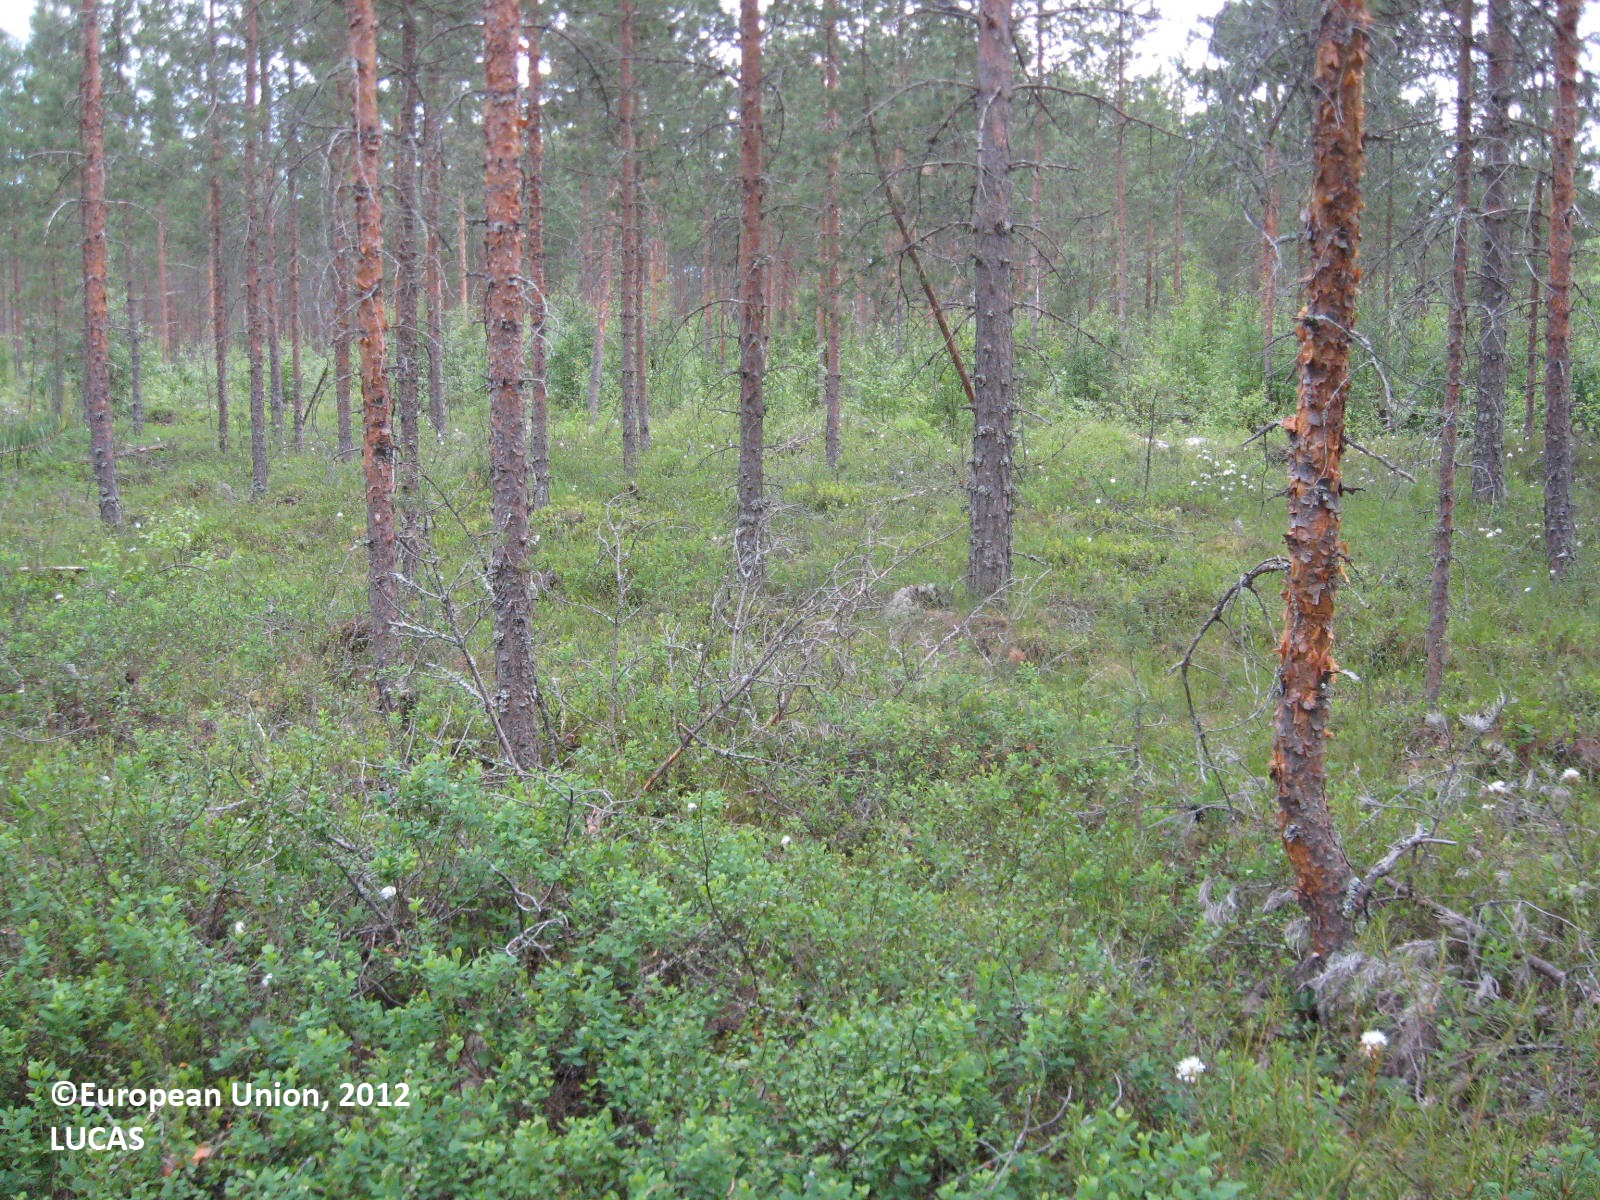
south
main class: Woodland
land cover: Pine dominated coniferous woodland
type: boreal forest
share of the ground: > 75 %
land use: Forestry
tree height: > 5 m
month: June
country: FI
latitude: 63.0081
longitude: 22.6736
